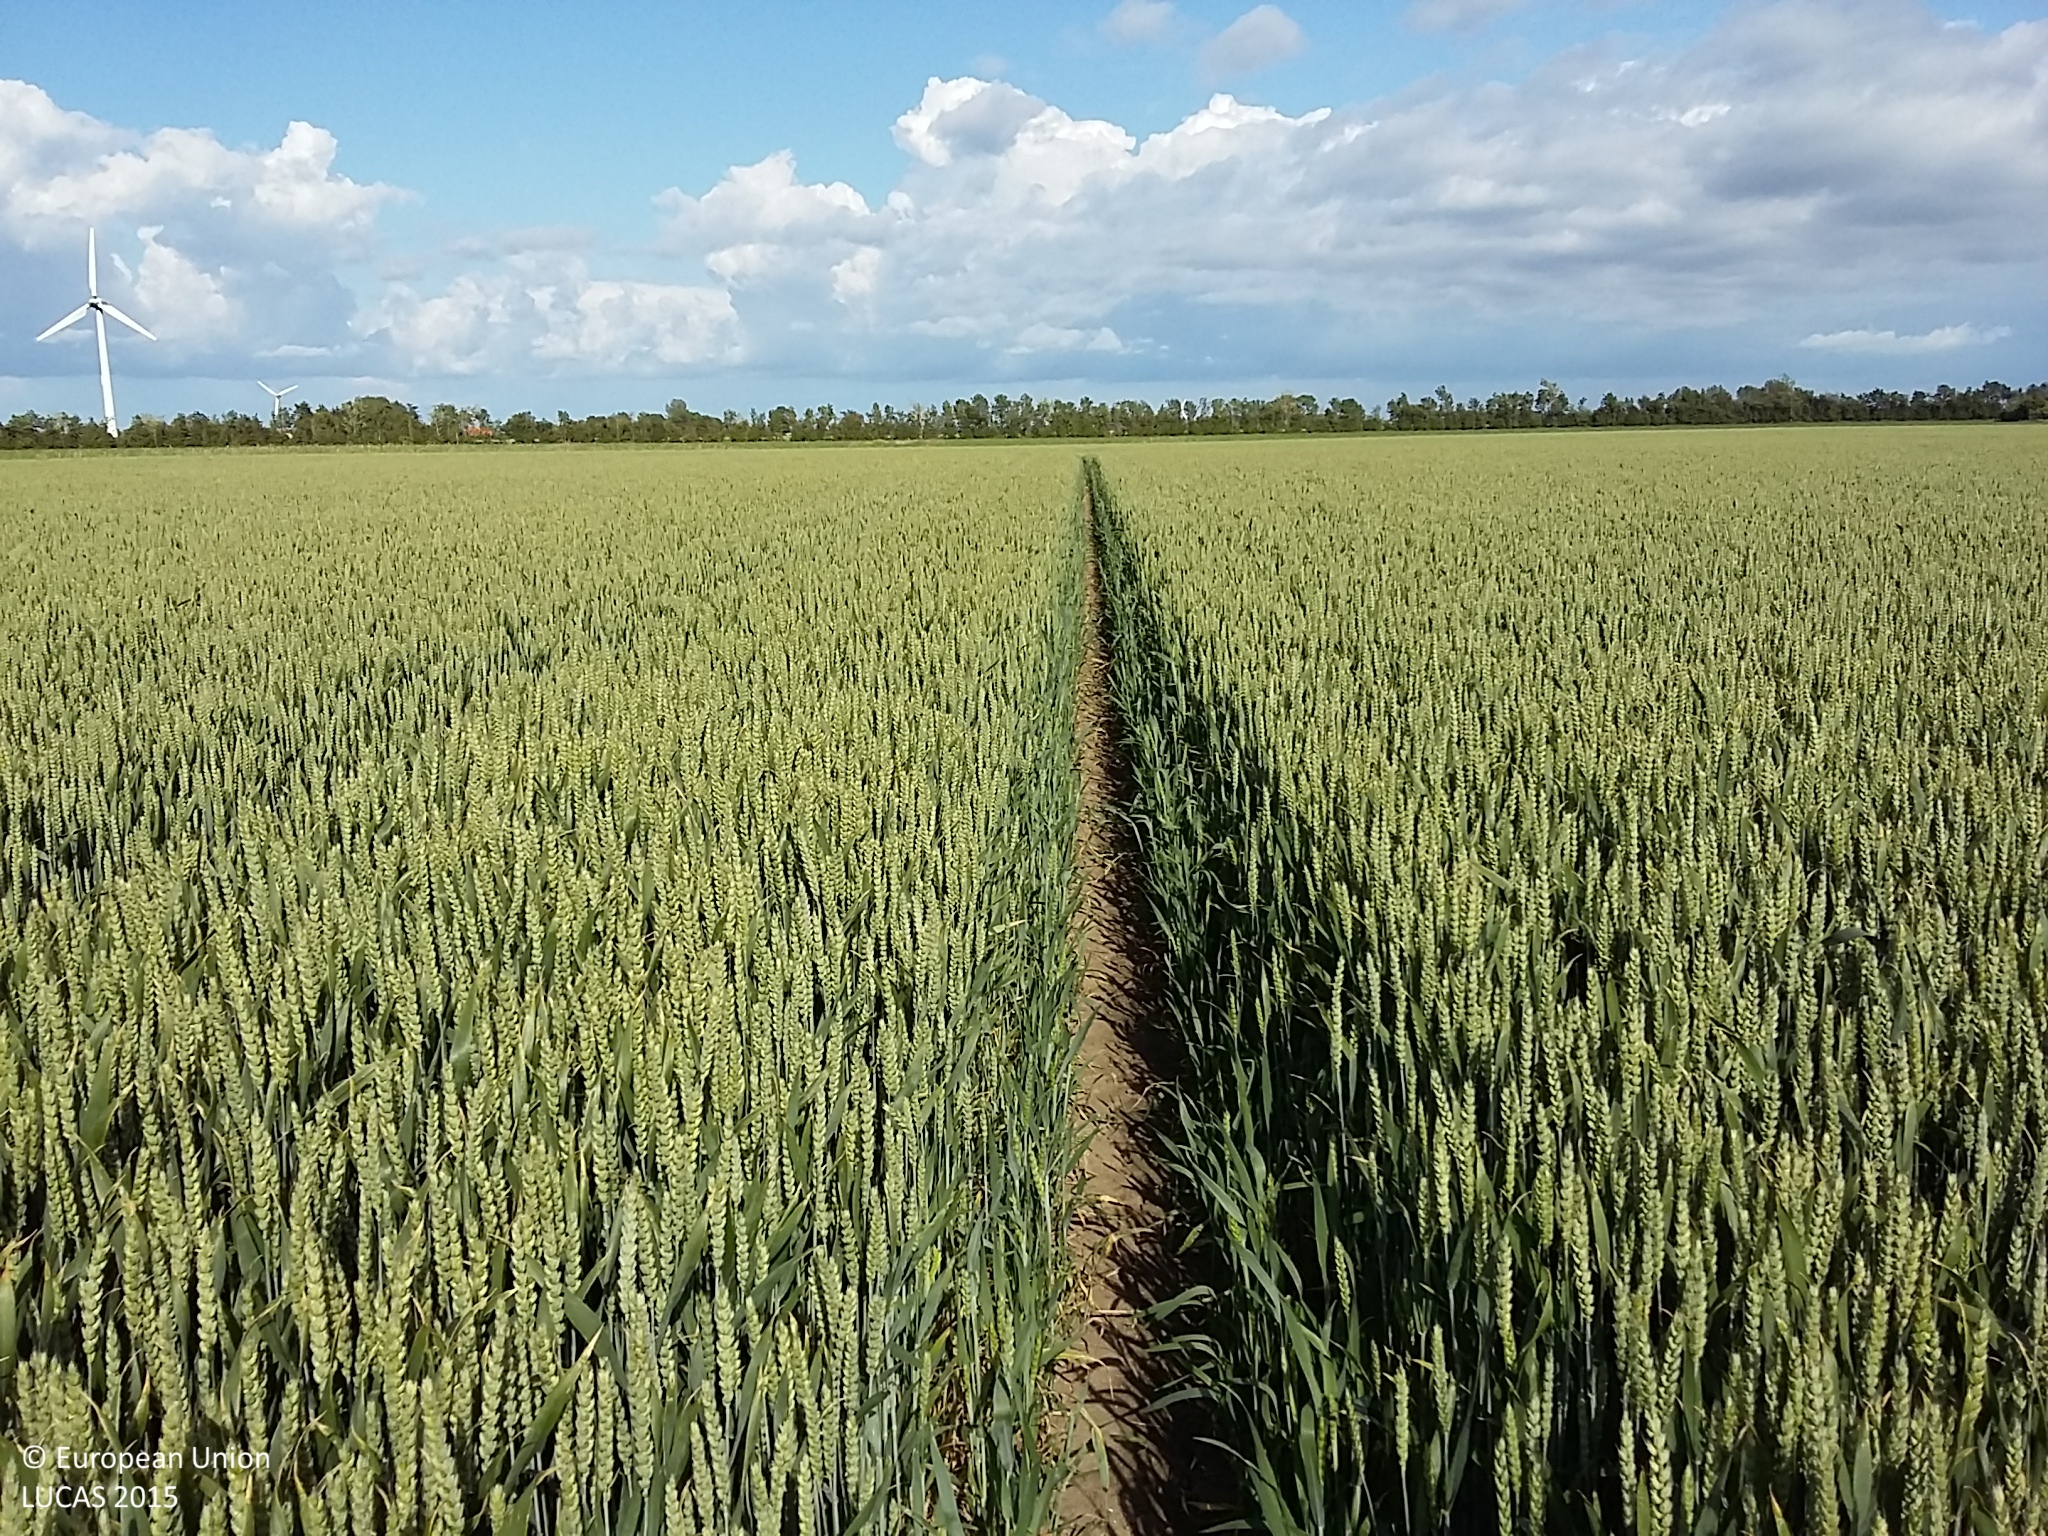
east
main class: Cropland
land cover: Common wheat
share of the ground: > 75 %
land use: Agriculture (excluding fallow land and kitchen gardens)
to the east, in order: Common wheat; Tracks; Sugar beet
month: June
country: DK
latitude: 54.7809
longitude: 11.1031
